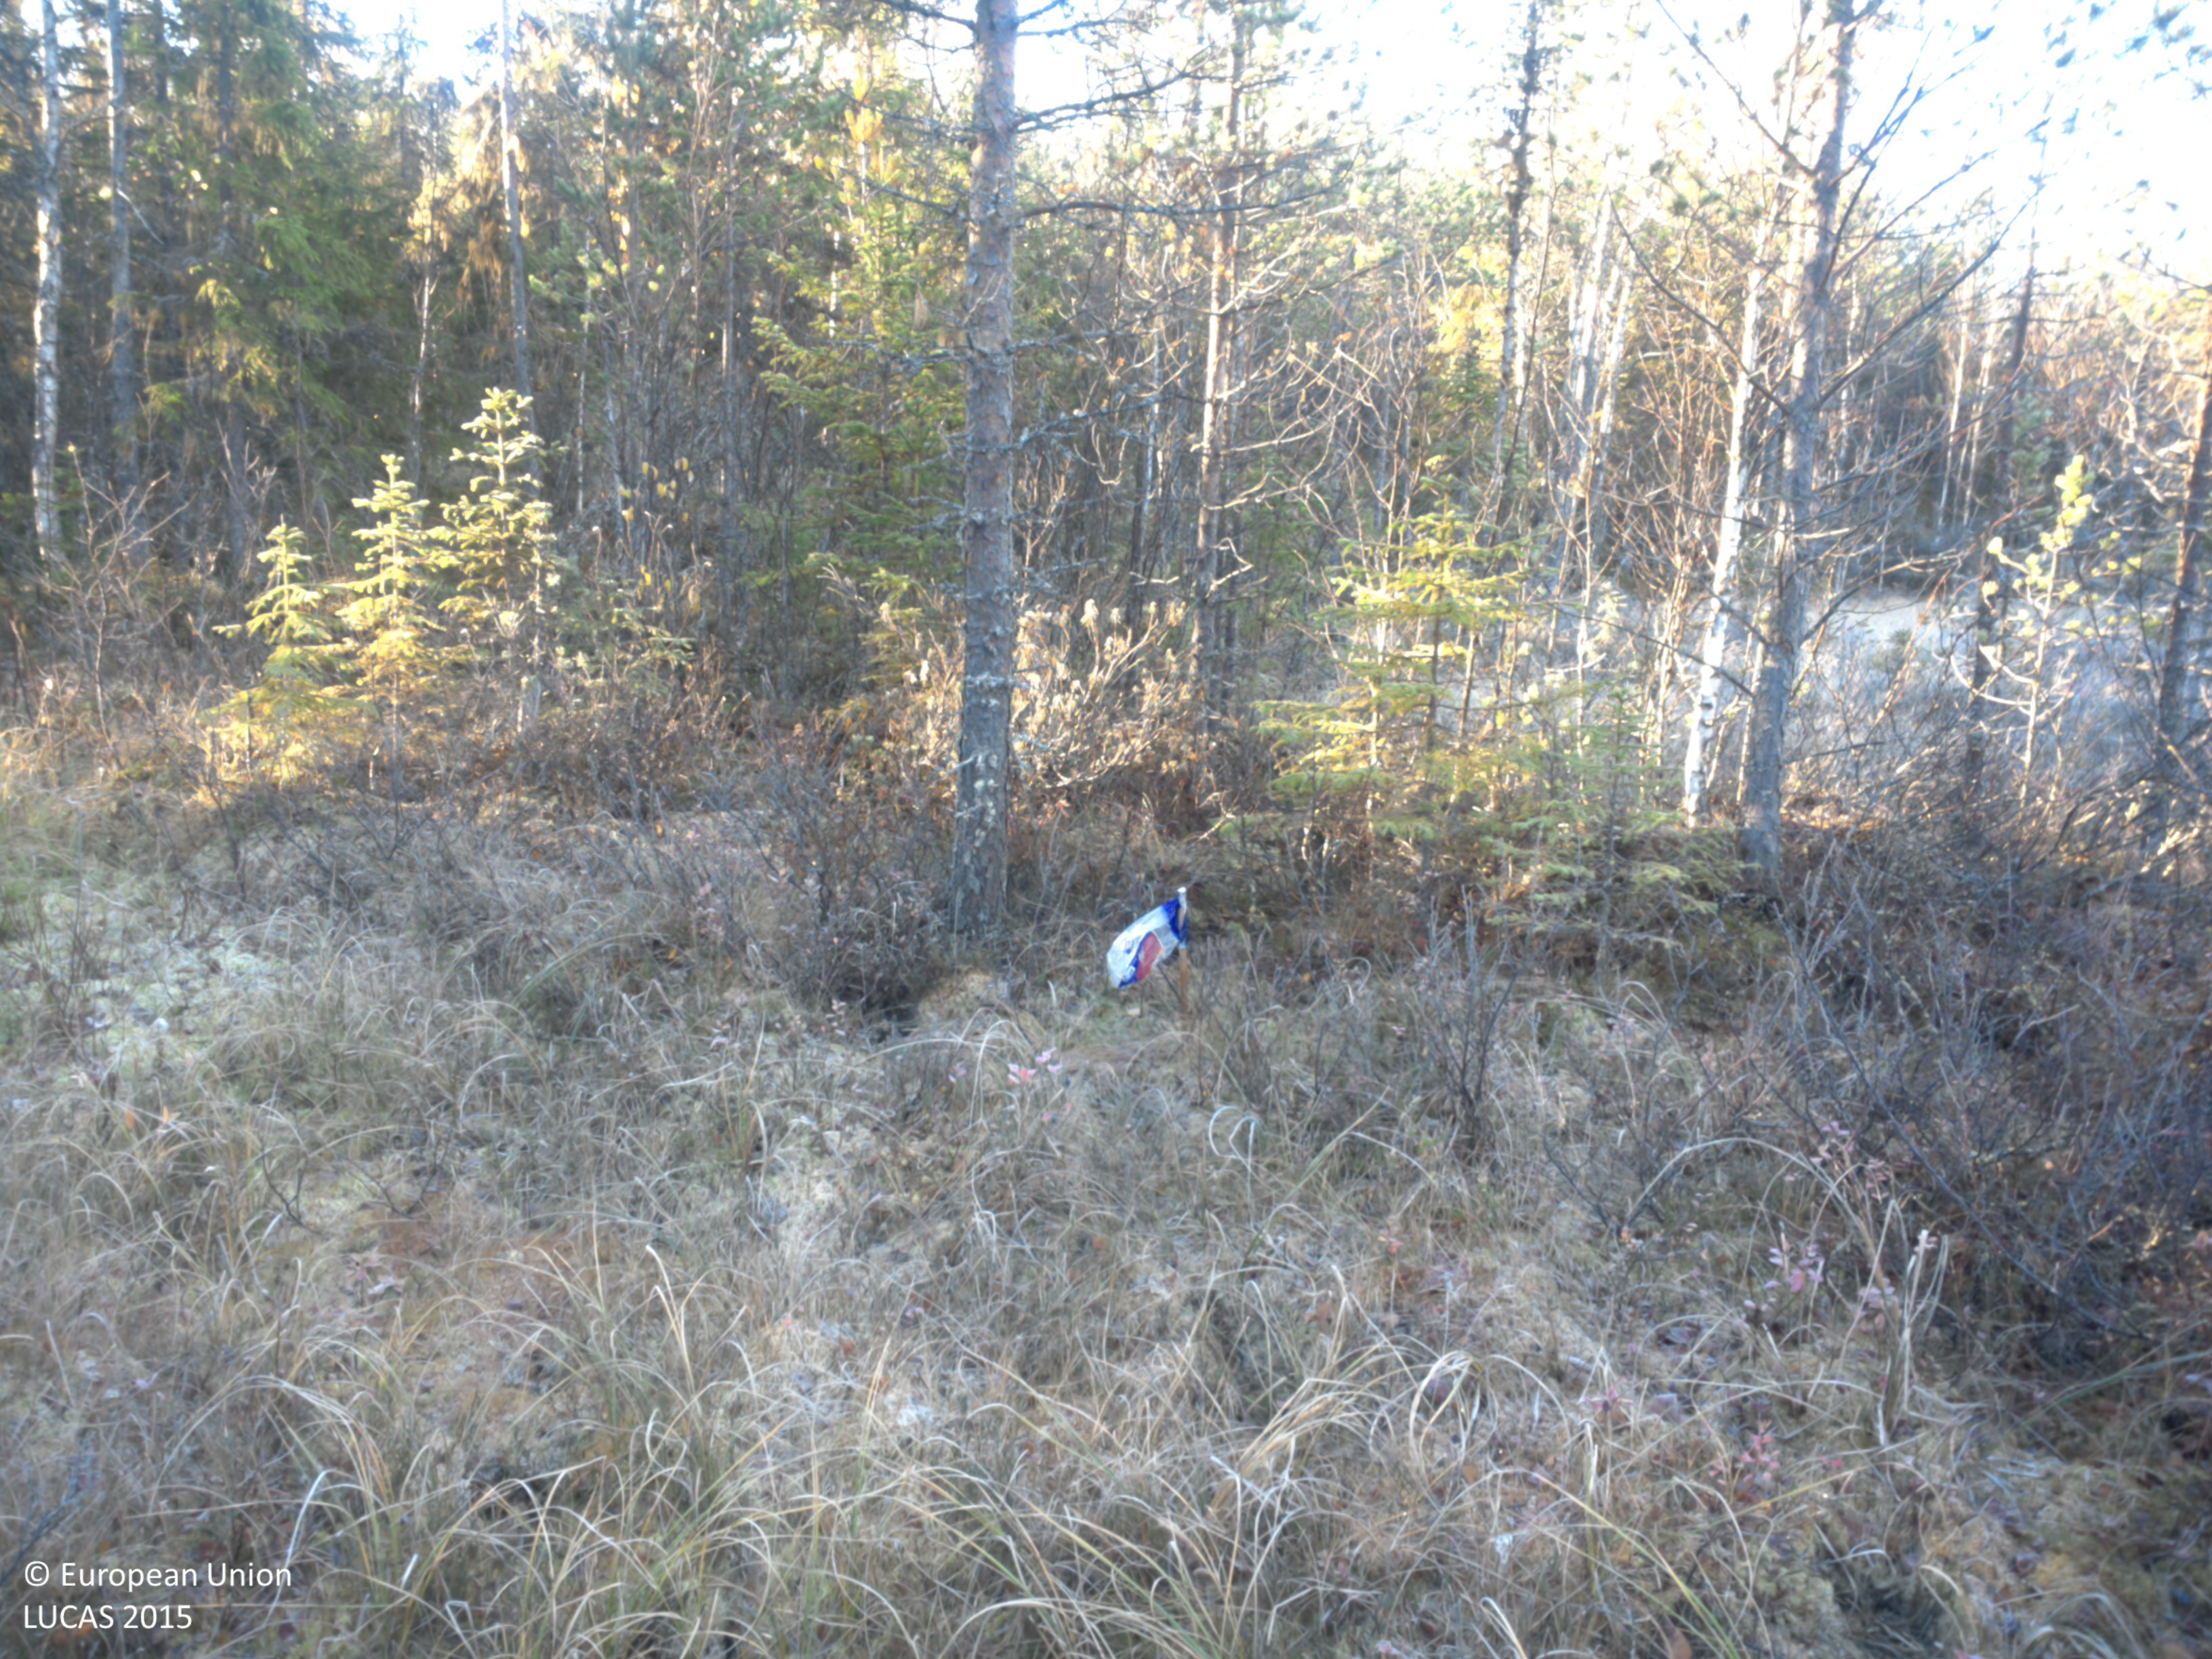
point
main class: Woodland
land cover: Pine dominated mixed woodland
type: boreal forest
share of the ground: 25 - 50 %
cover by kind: coniferous forest trees 30 %, shrubs 25 %, herbaceous plants 25 %, broadleaved forest trees 10 %, lichens and mosses 10 %
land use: Forestry
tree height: < 5 m
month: October
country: SE
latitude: 64.8019
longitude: 18.2385
